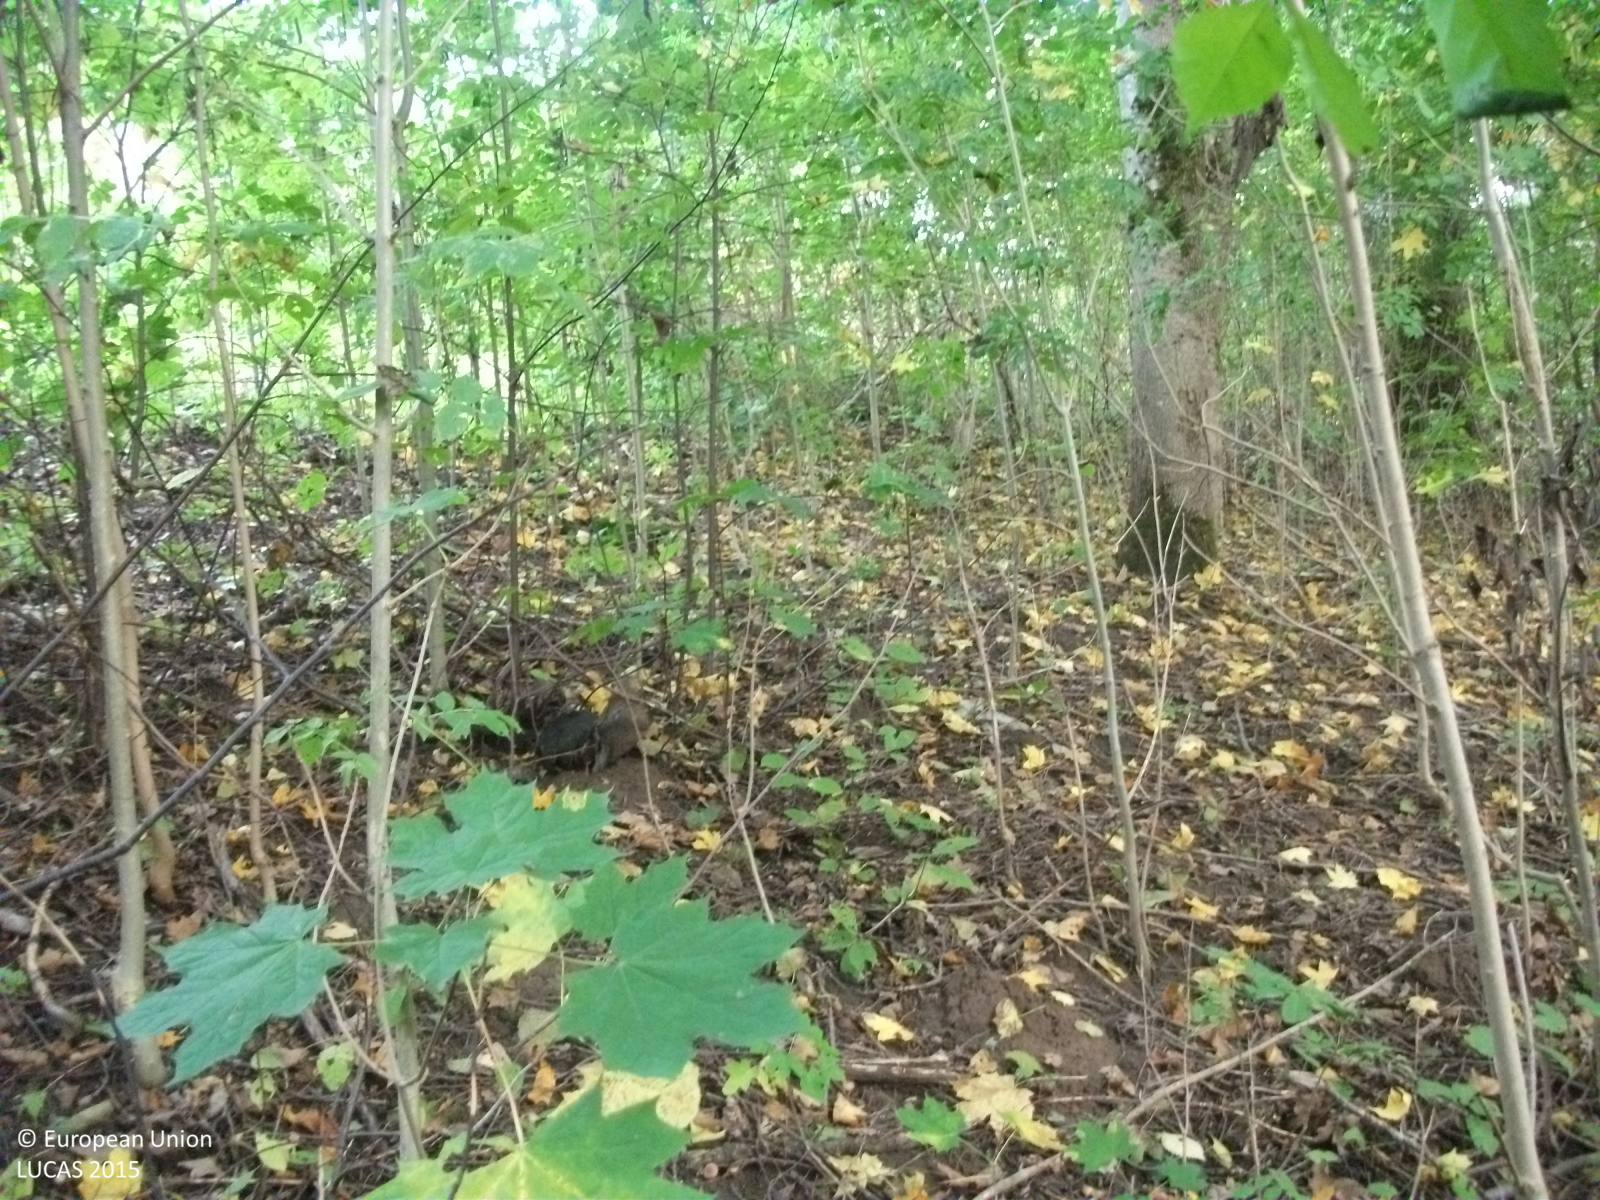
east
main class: Woodland
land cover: Broadleaved woodland
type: non-riverine alder, birch or aspen forest
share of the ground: > 75 %
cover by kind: broadleaved forest trees 90 %, herbaceous plants 5 %, unconsolidated bare surface 5 %
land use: Semi-natural and natural areas not in use
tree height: > 5 m
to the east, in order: Broadleaved woodland; Grassland with sparse tree/shrub cover; Apple fruit; Electric lines; Apple fruit; Grassland without tree/shrub cover; Lines of trees; Grassland without tree/shrub cover; Artificial constructions in urban areas; Grassland without tree/shrub cover; Potatoes; Grass margins; Tracks; Grass margins; Common wheat; Grass margins; Ditches and canals; Shruby margins; Common wheat; Electric lines; Common wheat
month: September
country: LV
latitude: 57.8872
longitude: 24.6477
